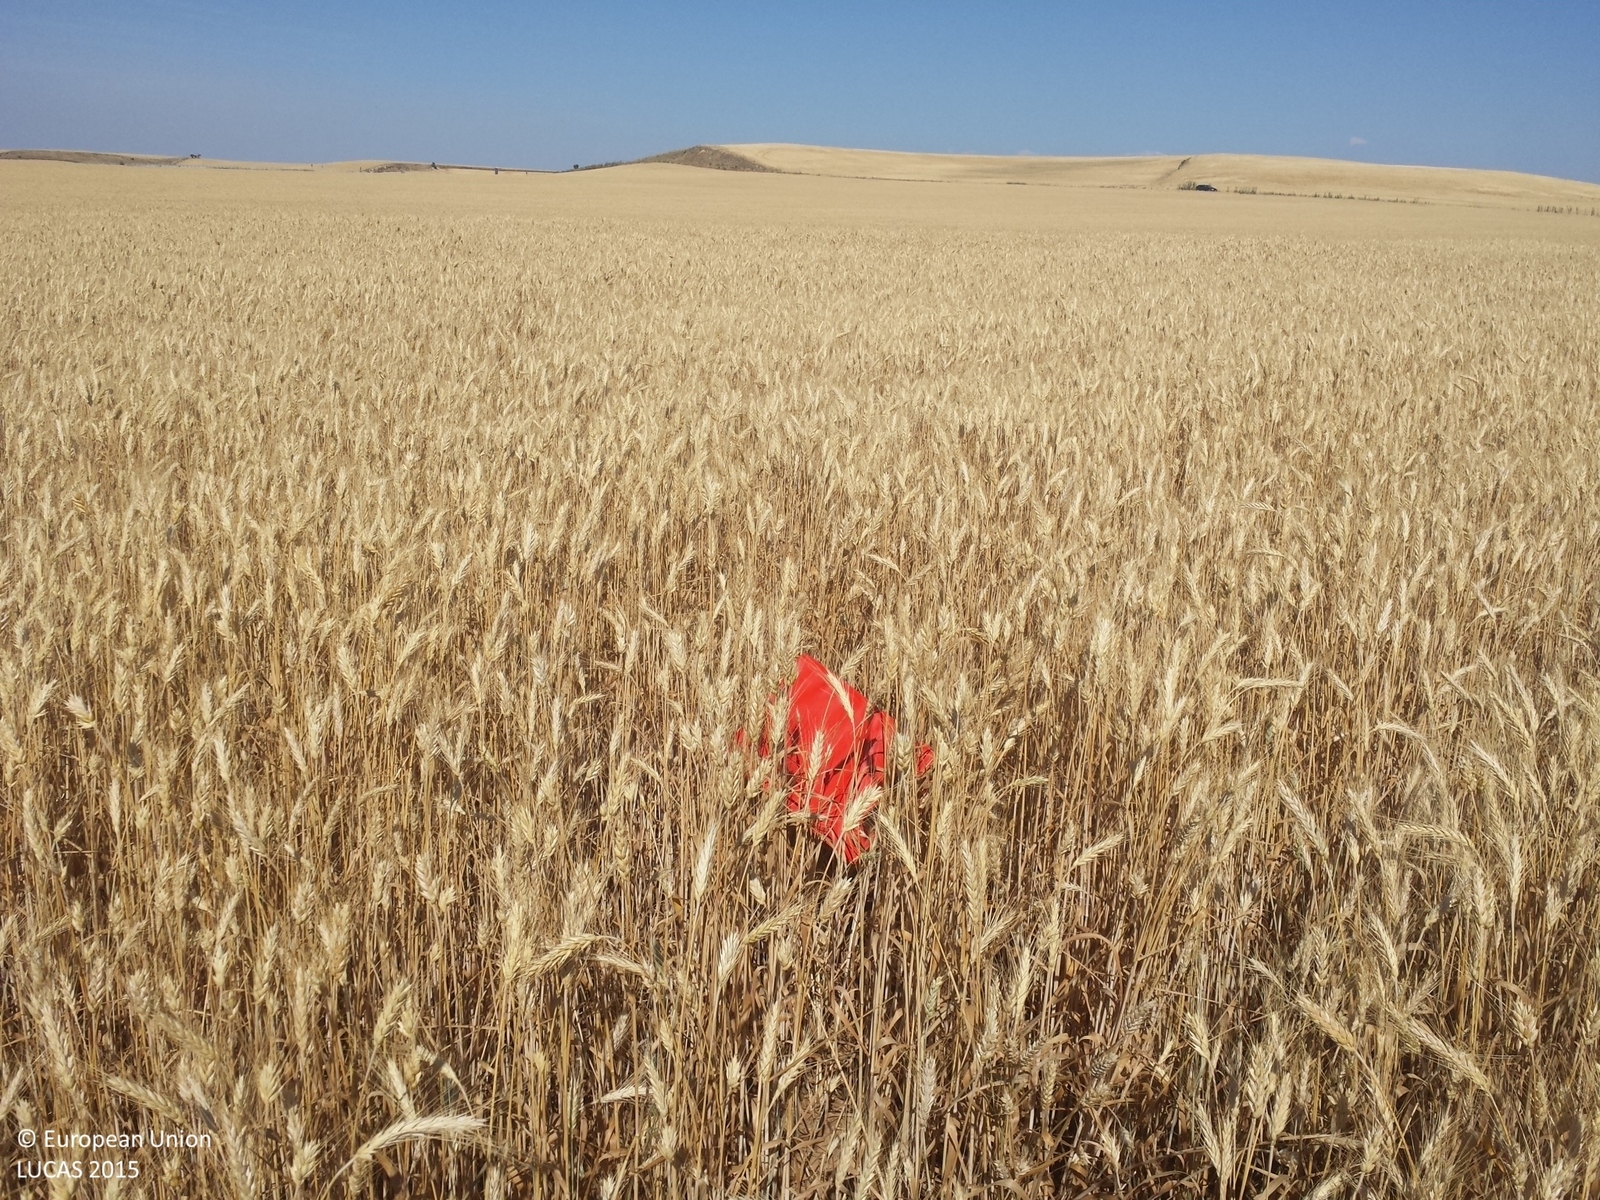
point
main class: Cropland
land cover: Common wheat
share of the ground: > 75 %
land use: Agriculture (excluding fallow land and kitchen gardens)
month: May
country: ES
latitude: 41.7206
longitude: 0.5505
